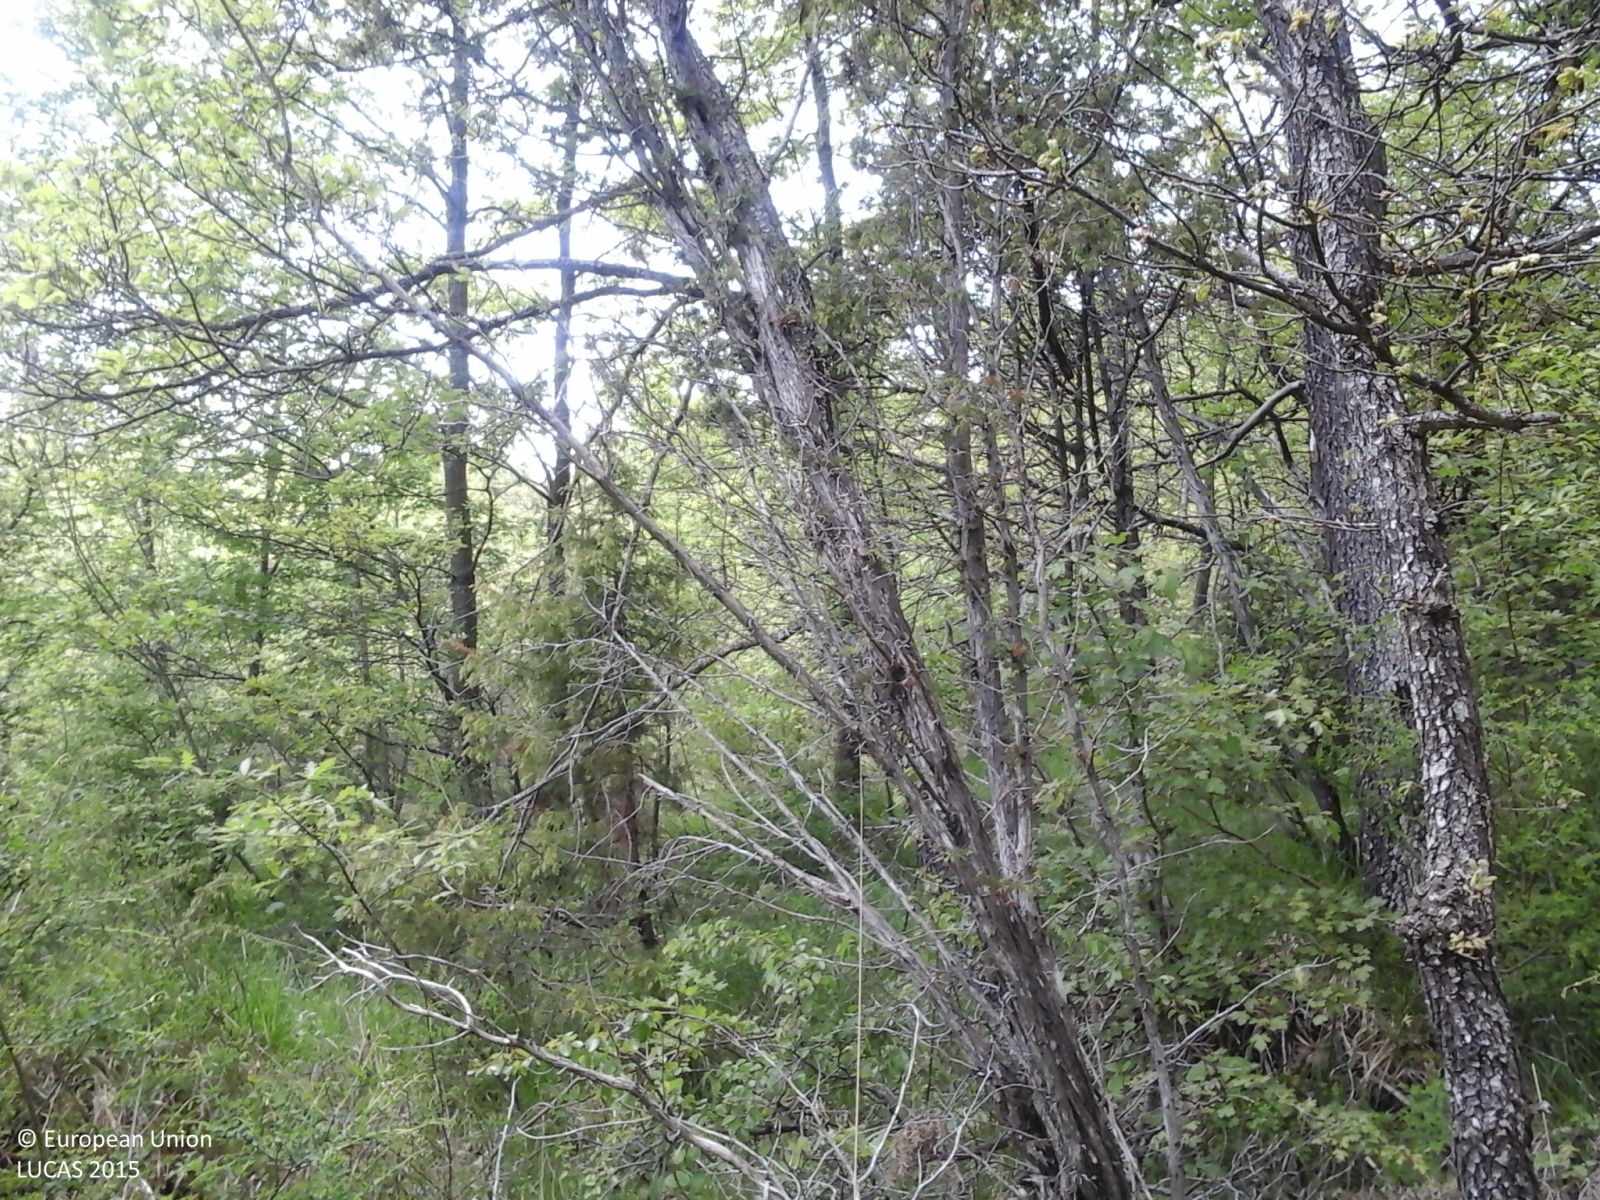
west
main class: Woodland
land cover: Broadleaved woodland
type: thermophilous deciduous forest
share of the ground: > 75 %
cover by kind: broadleaved forest trees 80 %, shrubs 15 %, herbaceous plants 5 %
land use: Forestry
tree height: > 5 m
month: May
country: IT
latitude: 44.7644
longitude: 9.5587
